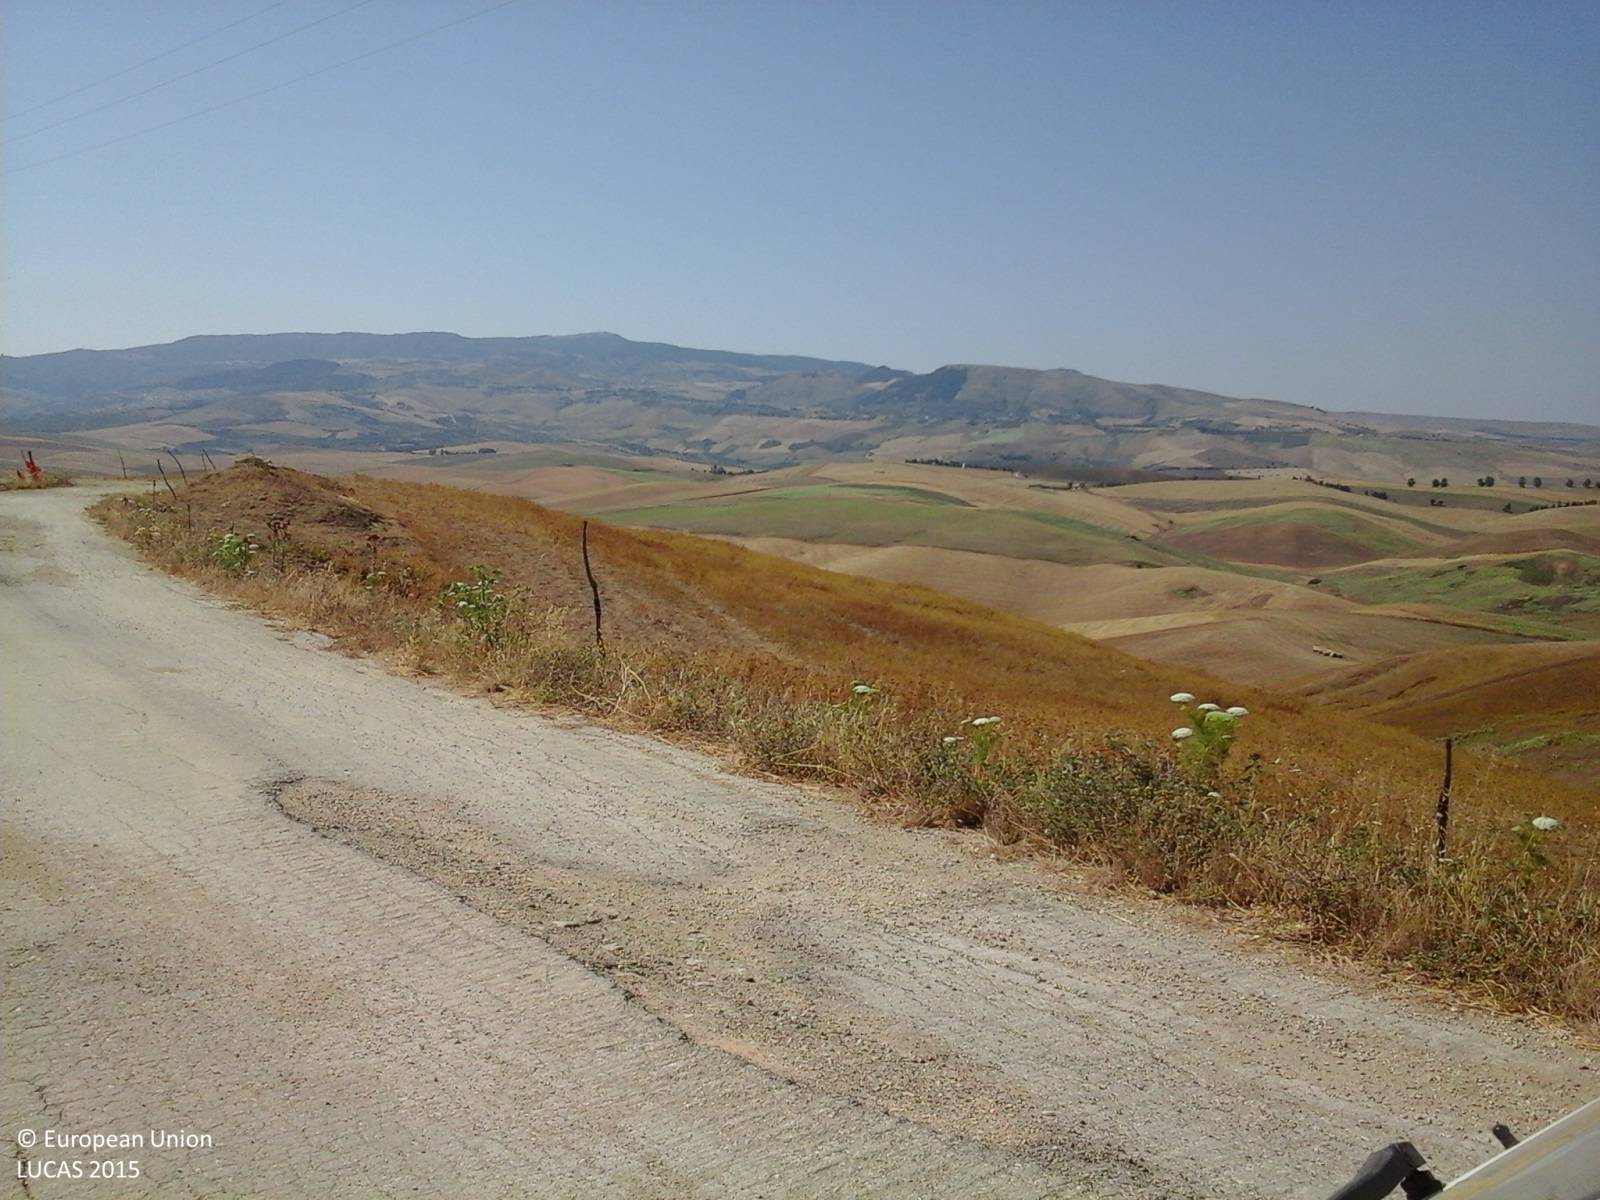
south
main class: Grassland
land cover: Grassland without tree/shrub cover
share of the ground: > 75 %
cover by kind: herbaceous plants 100 %
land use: Semi-natural and natural areas not in use
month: July
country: IT
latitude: 37.7864
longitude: 13.1449
